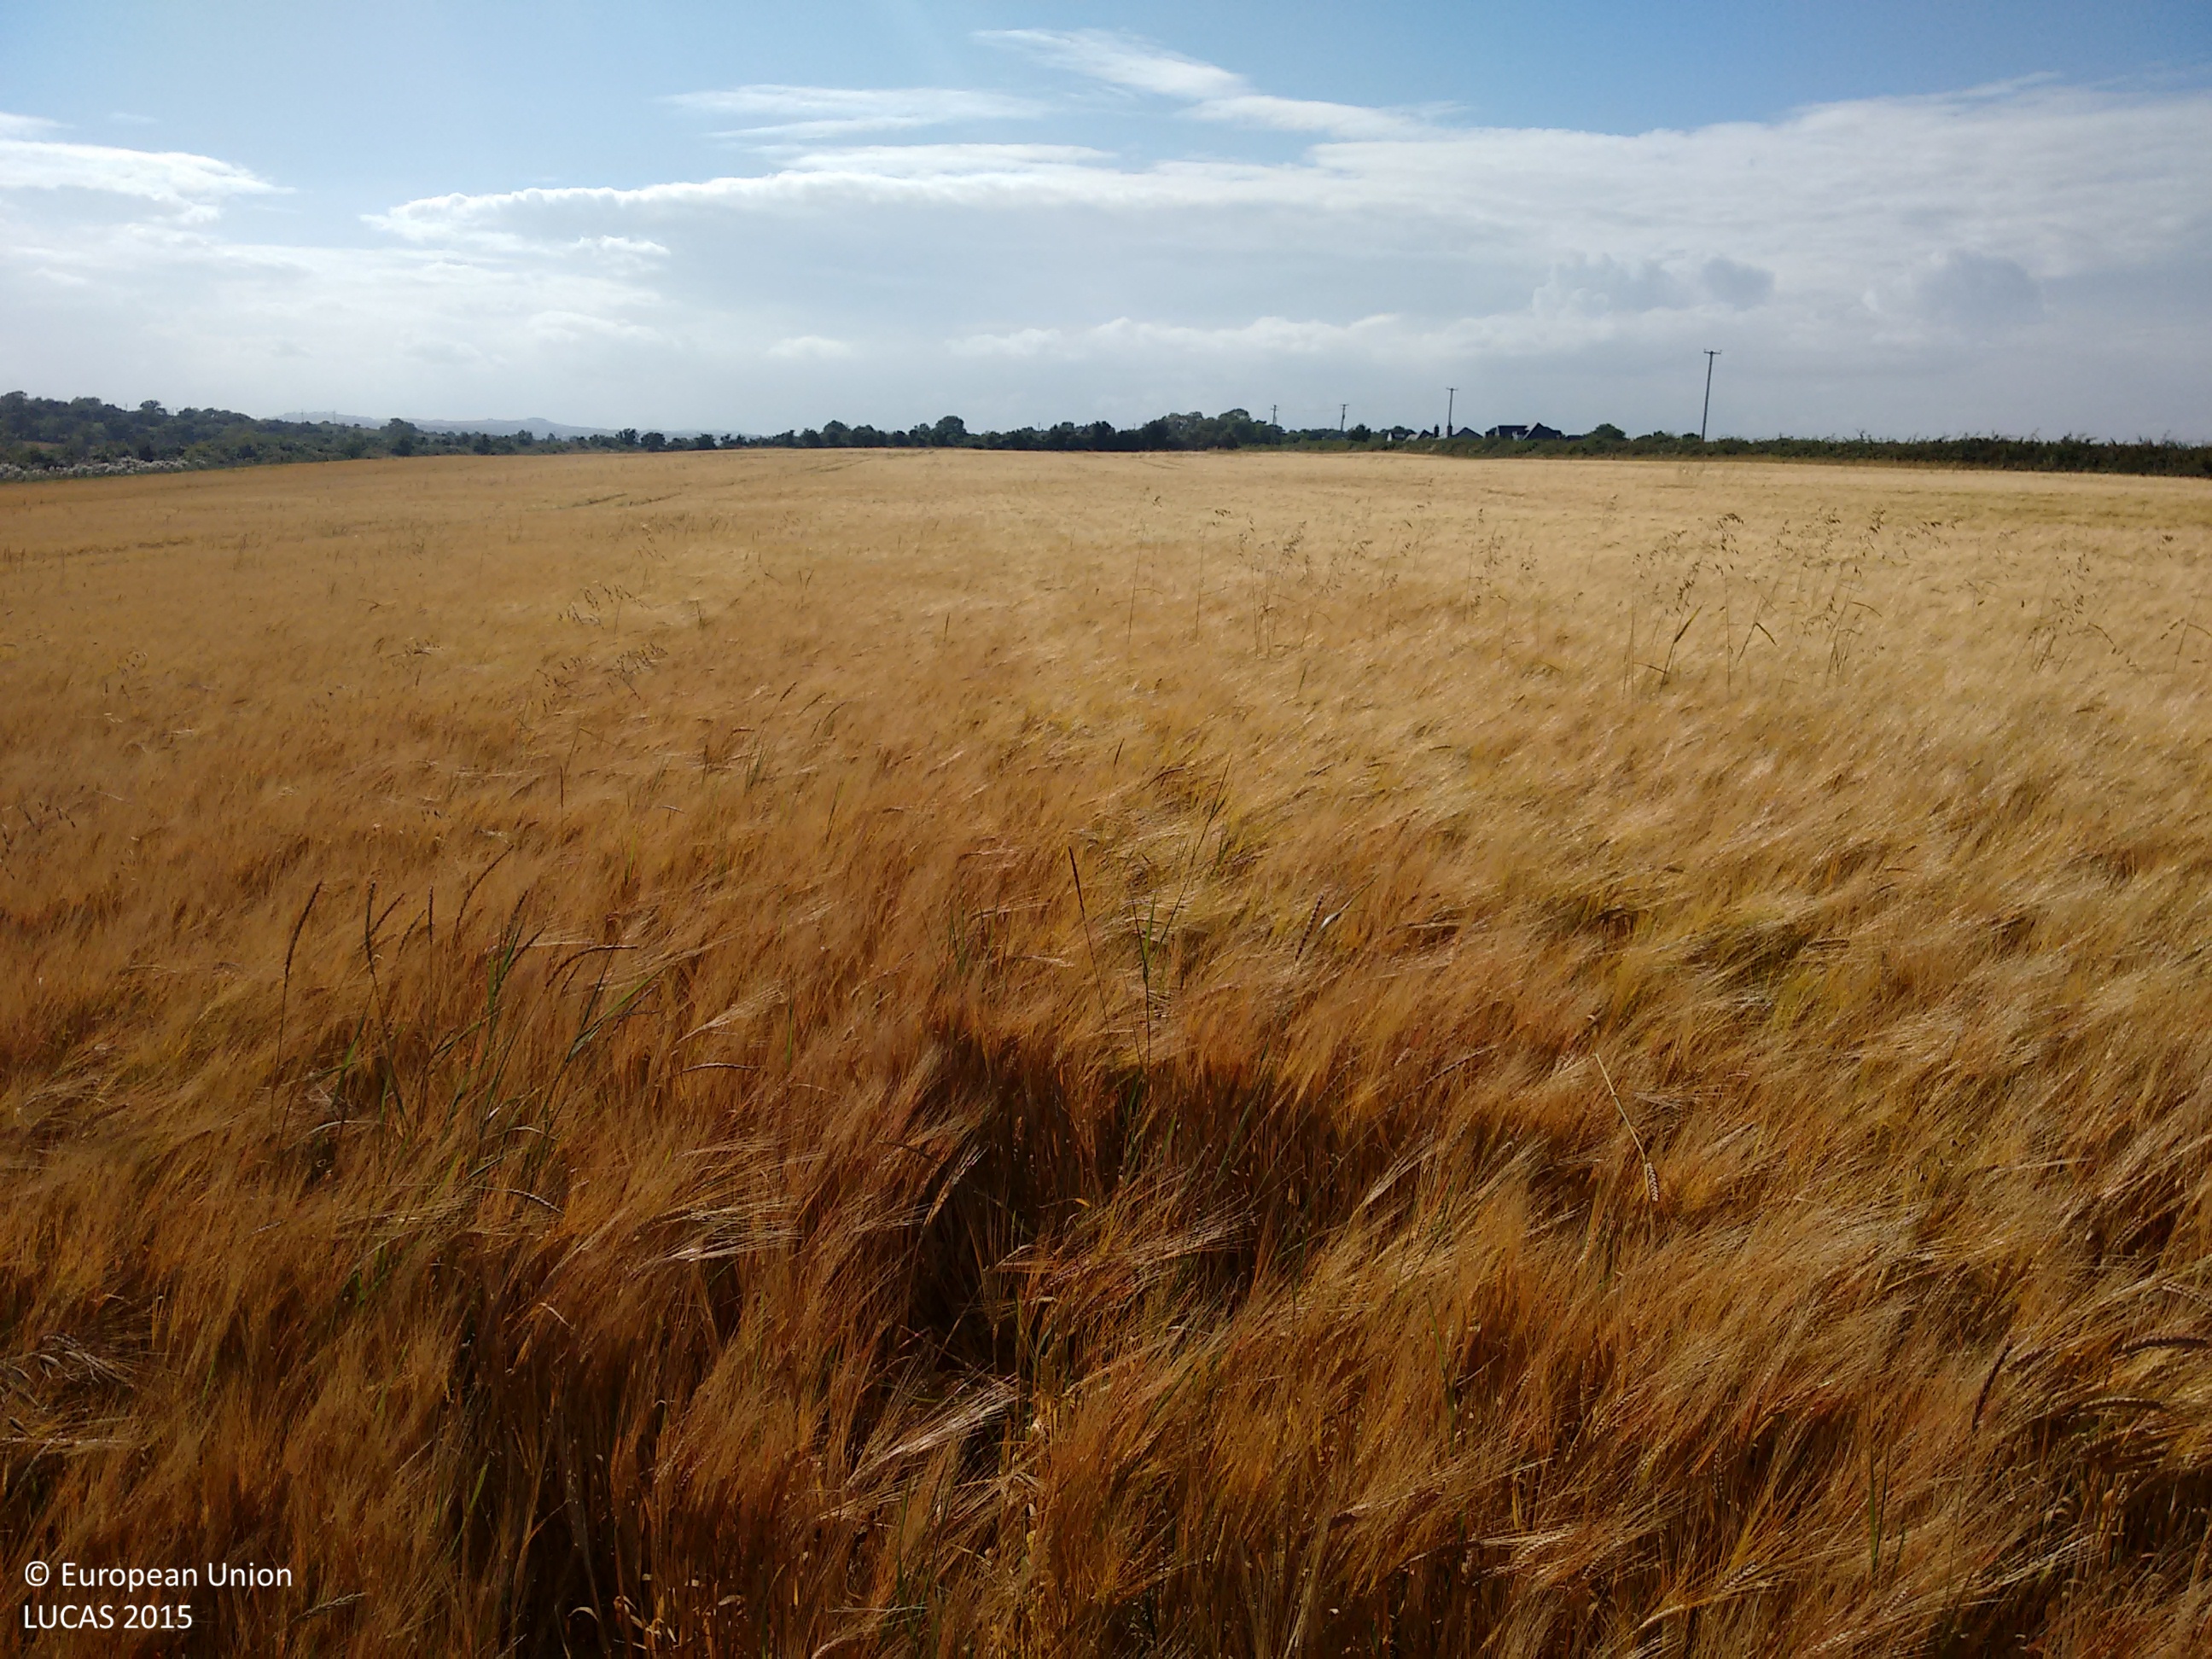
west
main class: Cropland
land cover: Barley
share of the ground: > 75 %
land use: Agriculture (excluding fallow land and kitchen gardens)
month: August
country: IE
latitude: 53.8644
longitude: -6.3152
